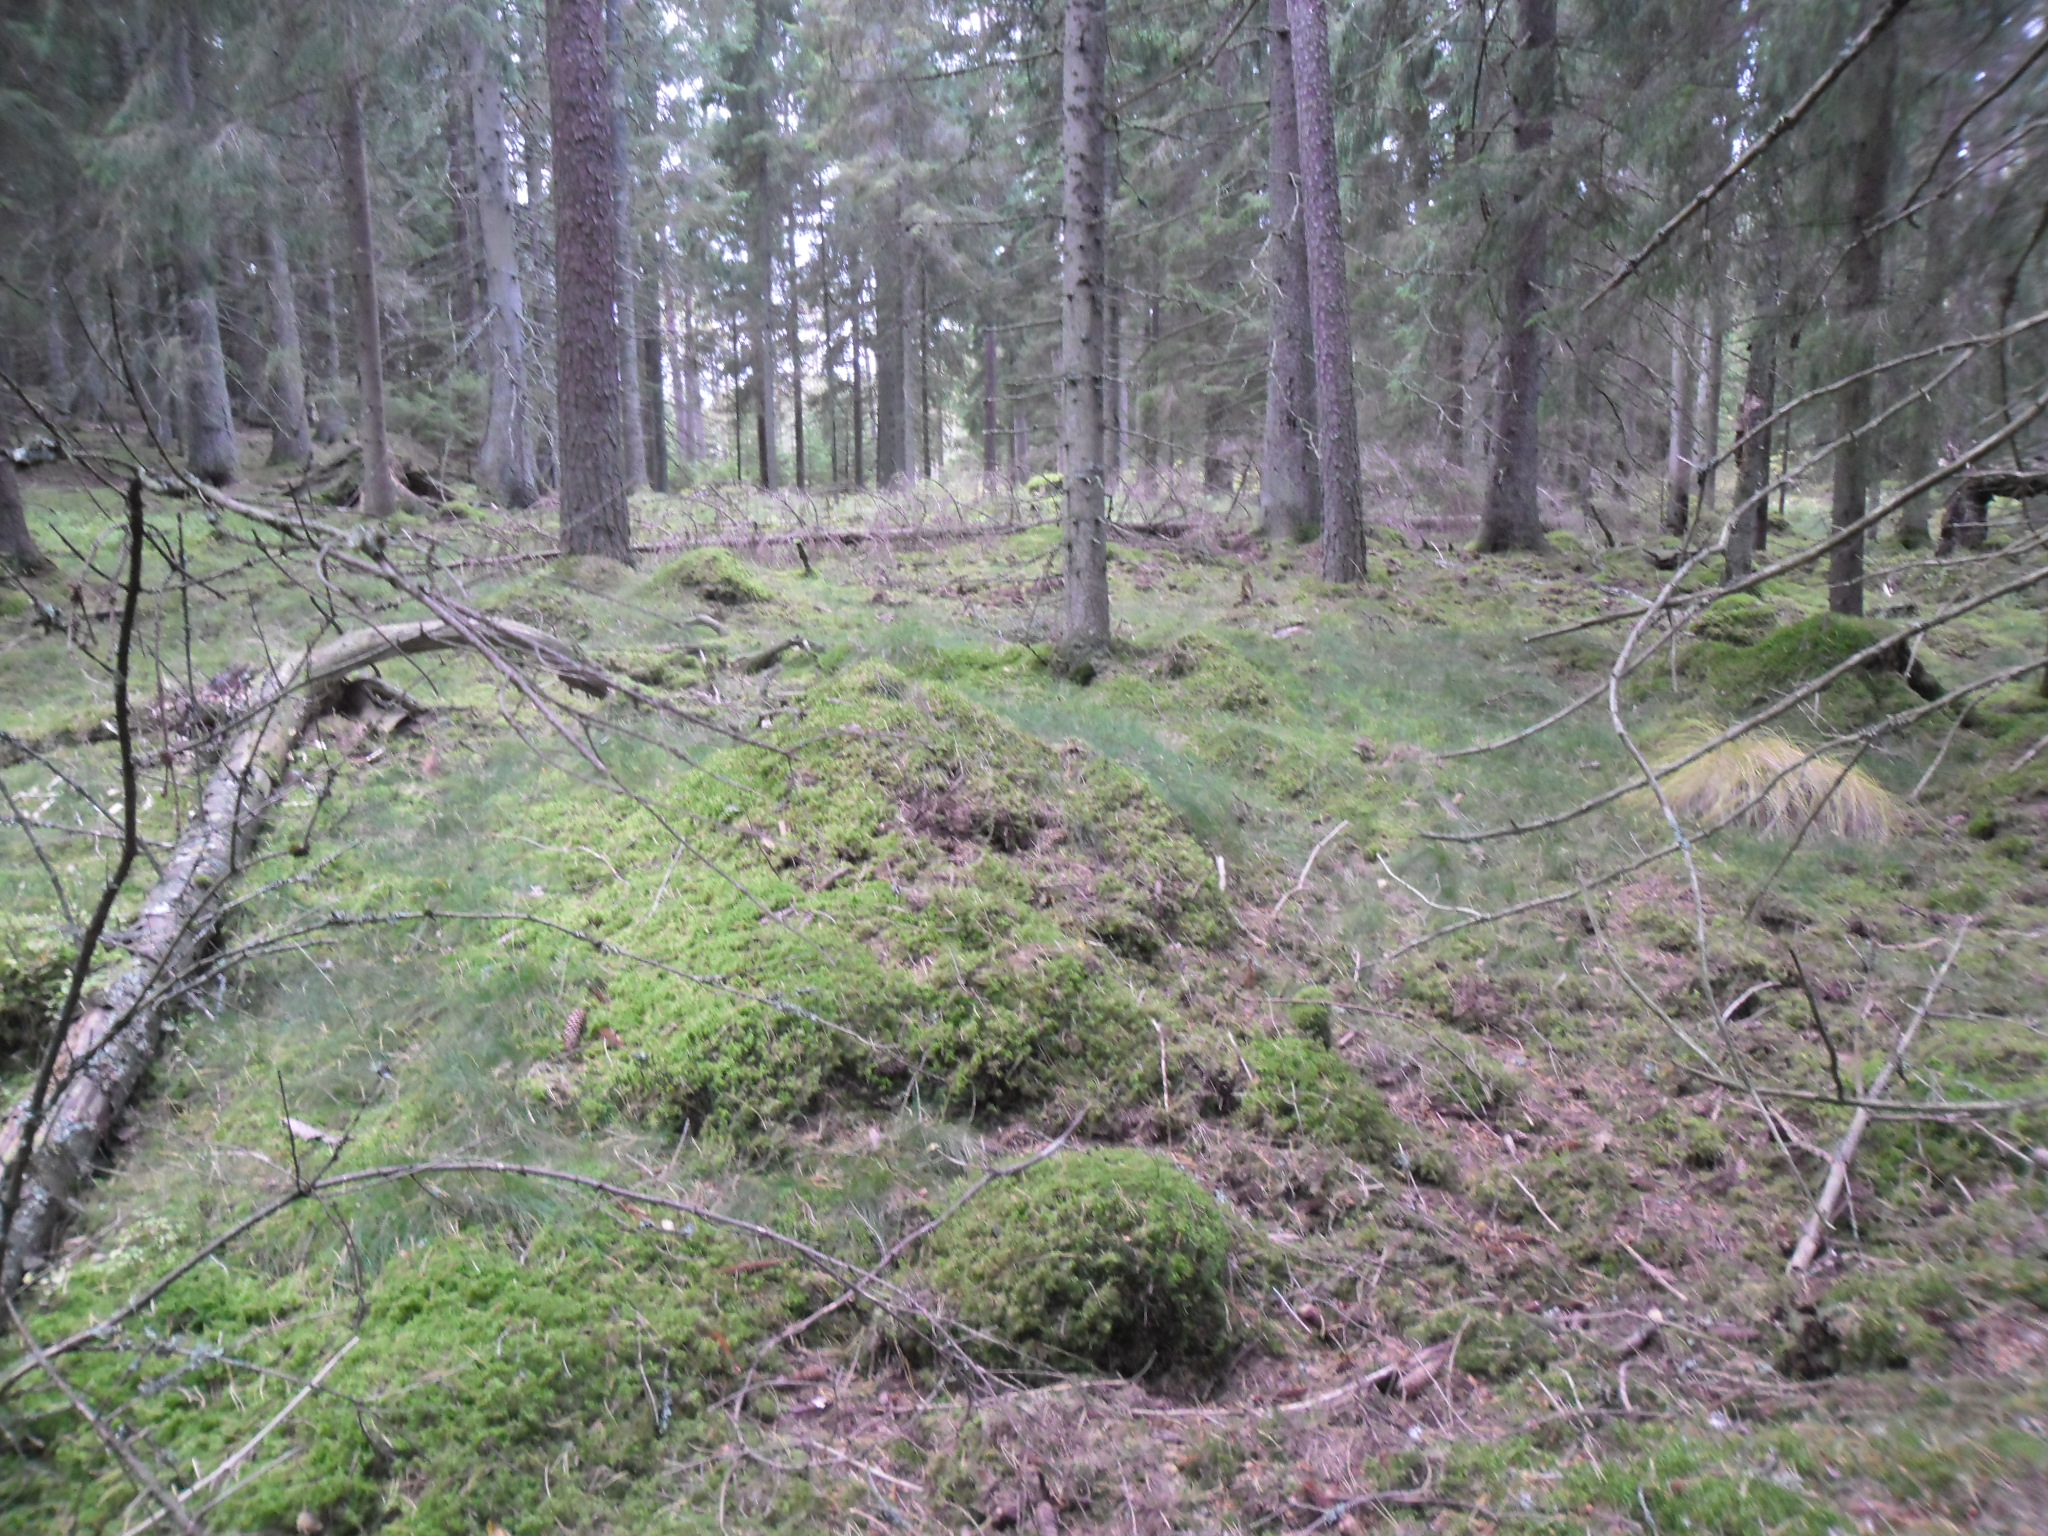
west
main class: Woodland
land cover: Spruce dominated coniferous woodland
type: boreal forest
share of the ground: > 75 %
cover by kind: coniferous forest trees 75 %, lichens and mosses 20 %, shrubs 5 %
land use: Forestry
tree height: > 5 m
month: October
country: SE
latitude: 56.4212
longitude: 13.7420
